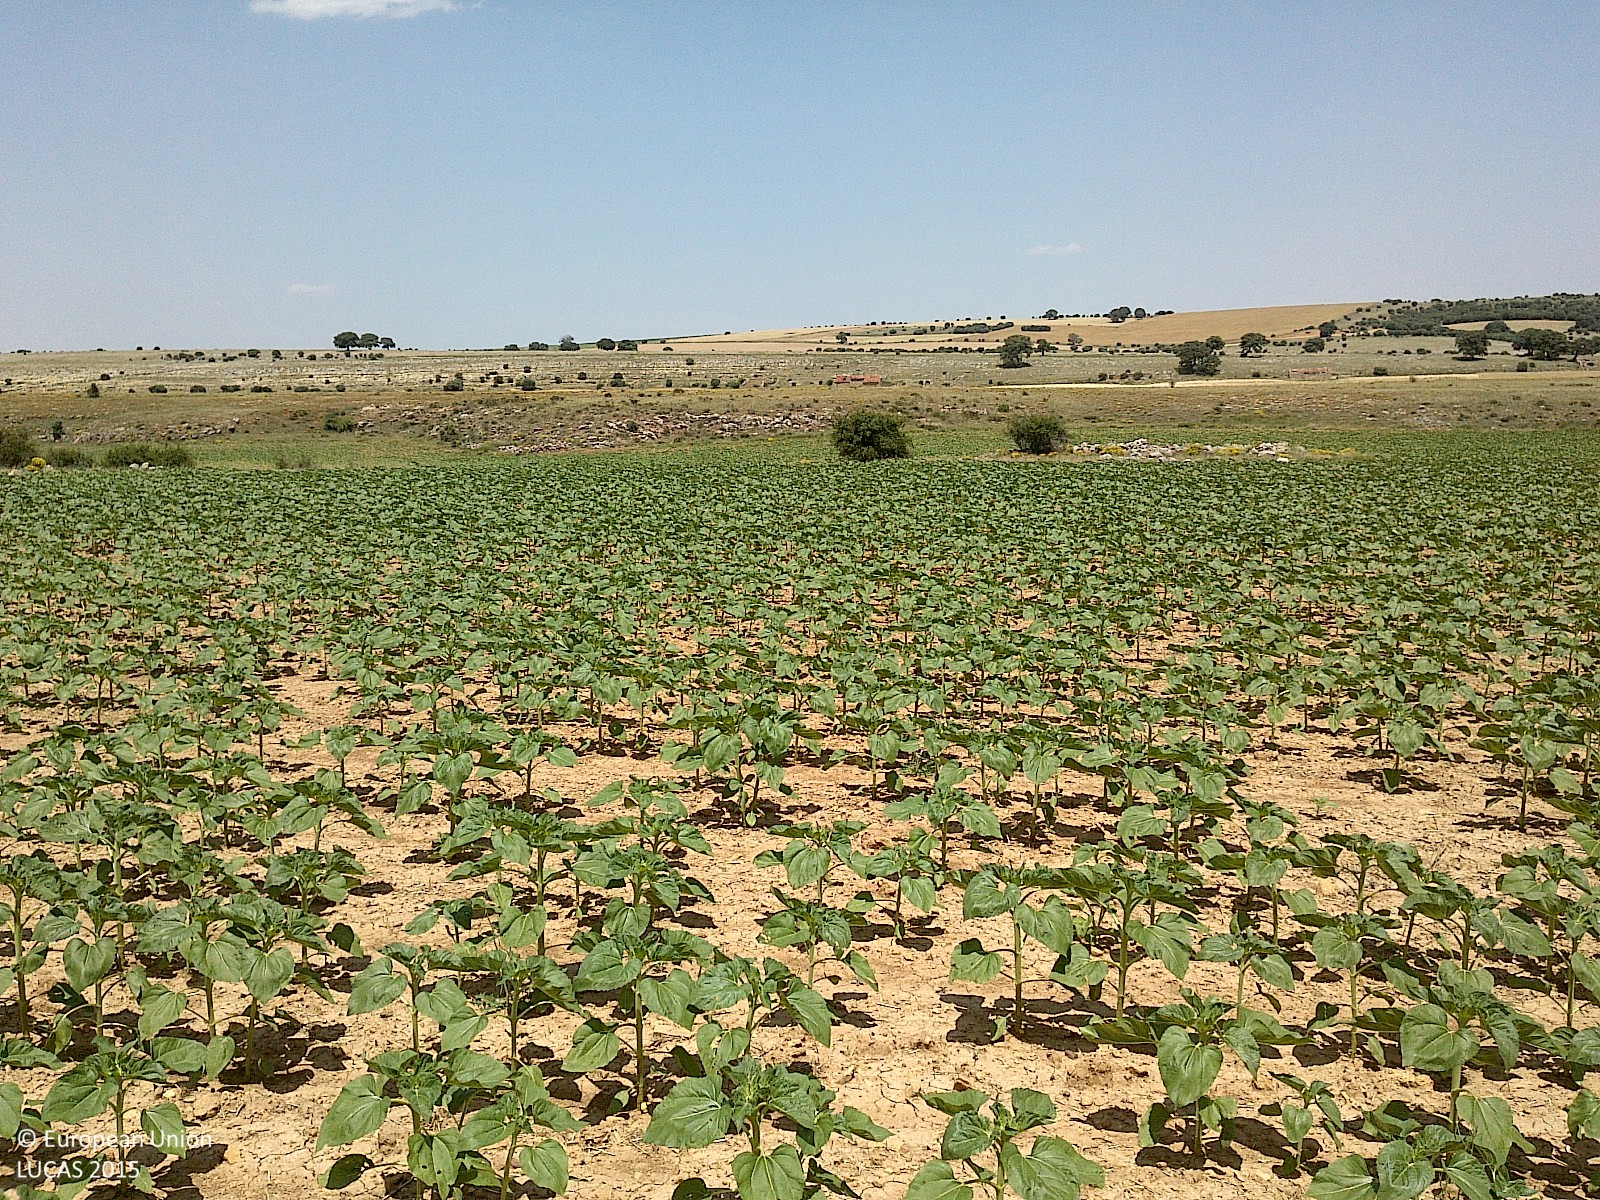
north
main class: Cropland
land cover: Sunflower
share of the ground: 10 - 25 %
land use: Agriculture (excluding fallow land and kitchen gardens)
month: July
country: ES
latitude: 41.5894
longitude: -2.0153
